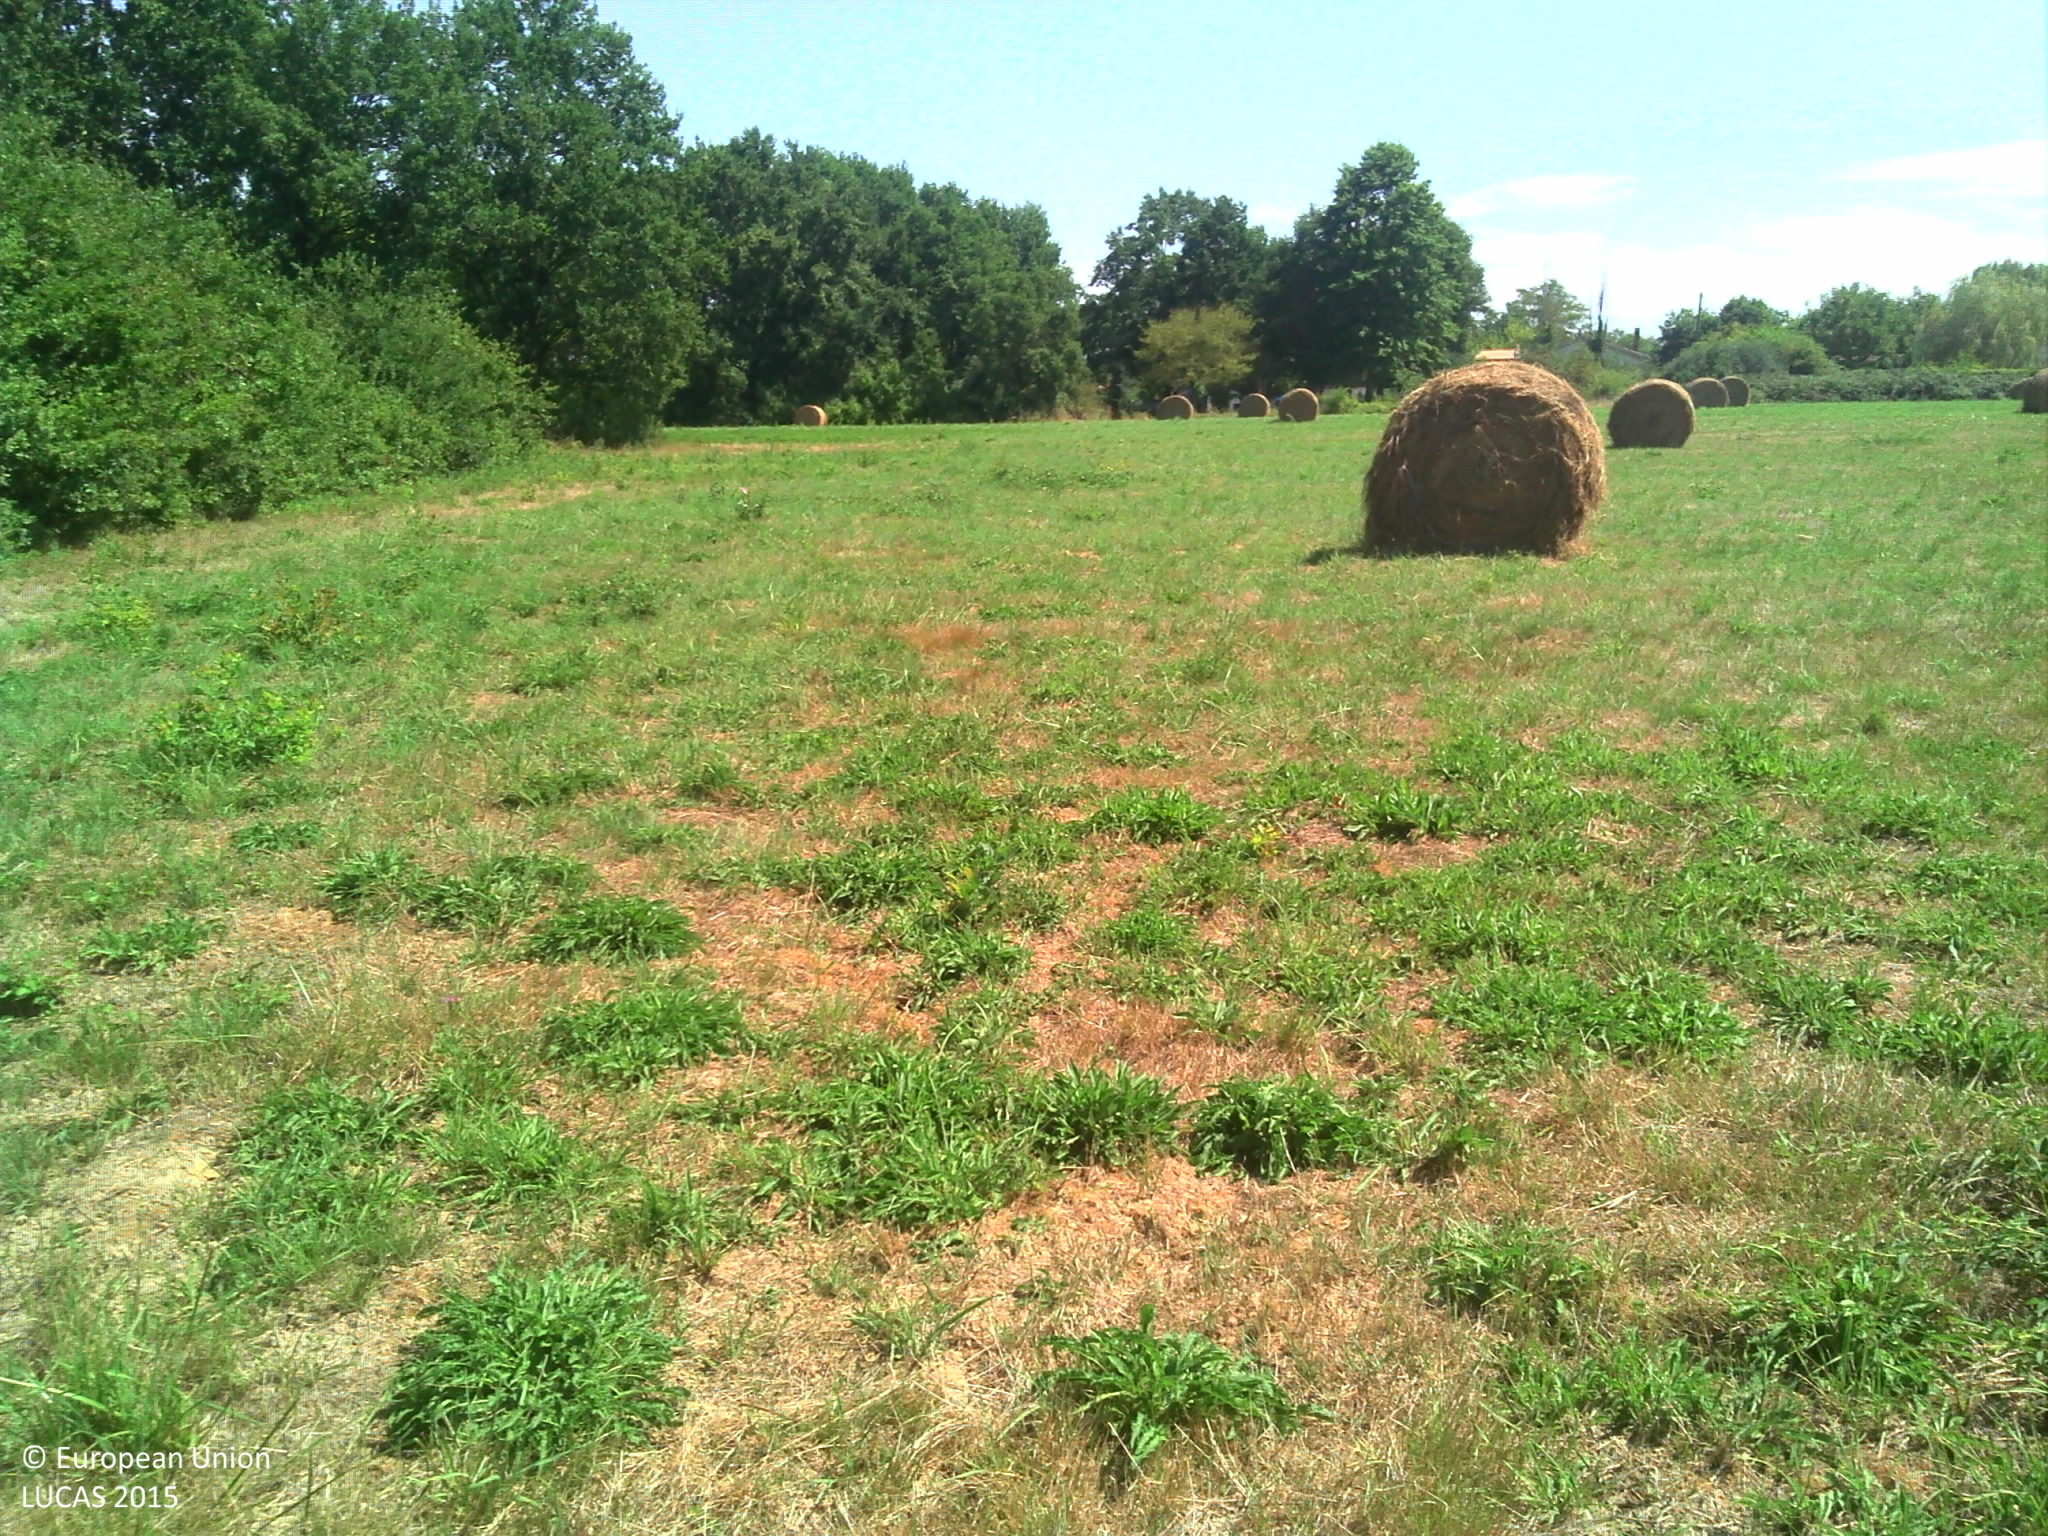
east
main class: Grassland
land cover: Grassland without tree/shrub cover
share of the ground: > 75 %
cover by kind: herbaceous plants 95 %, shrubs 5 %
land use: Agriculture (excluding fallow land and kitchen gardens)
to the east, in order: Grassland without tree/shrub cover; Artificial constructions in urban areas
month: August
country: FR
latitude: 44.0591
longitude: 1.3237
